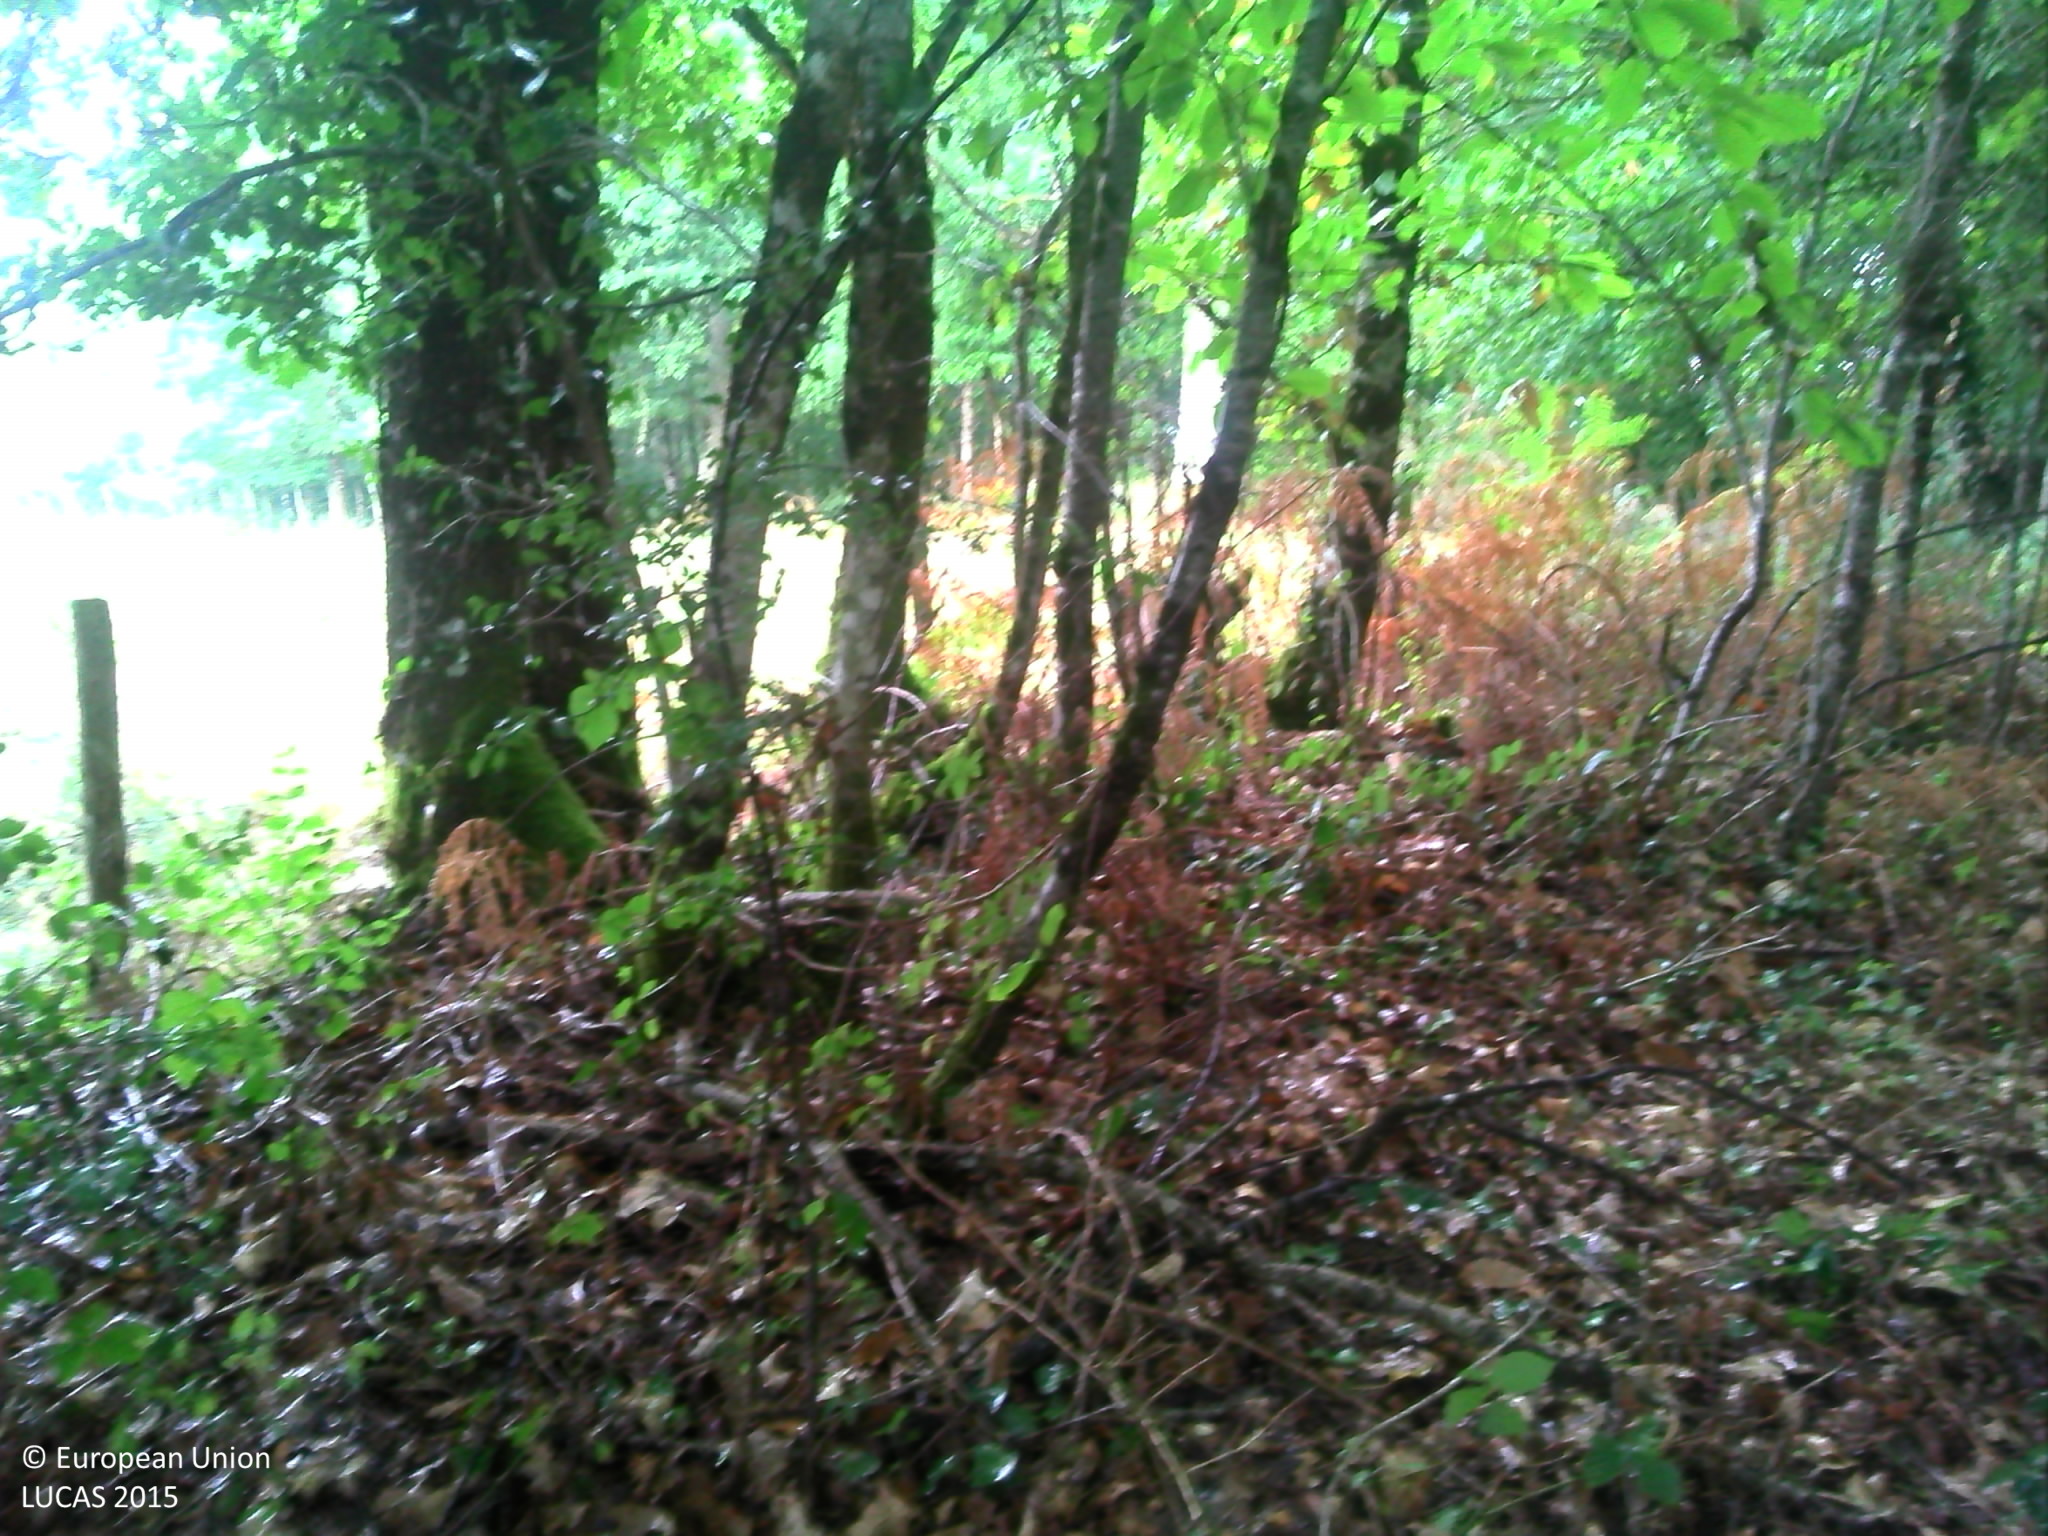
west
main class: Woodland
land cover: Broadleaved woodland
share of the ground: > 75 %
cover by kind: broadleaved forest trees 95 %, coniferous forest trees 5 %
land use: Semi-natural and natural areas not in use
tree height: > 5 m
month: August
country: FR
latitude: 45.9863
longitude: 0.9646
